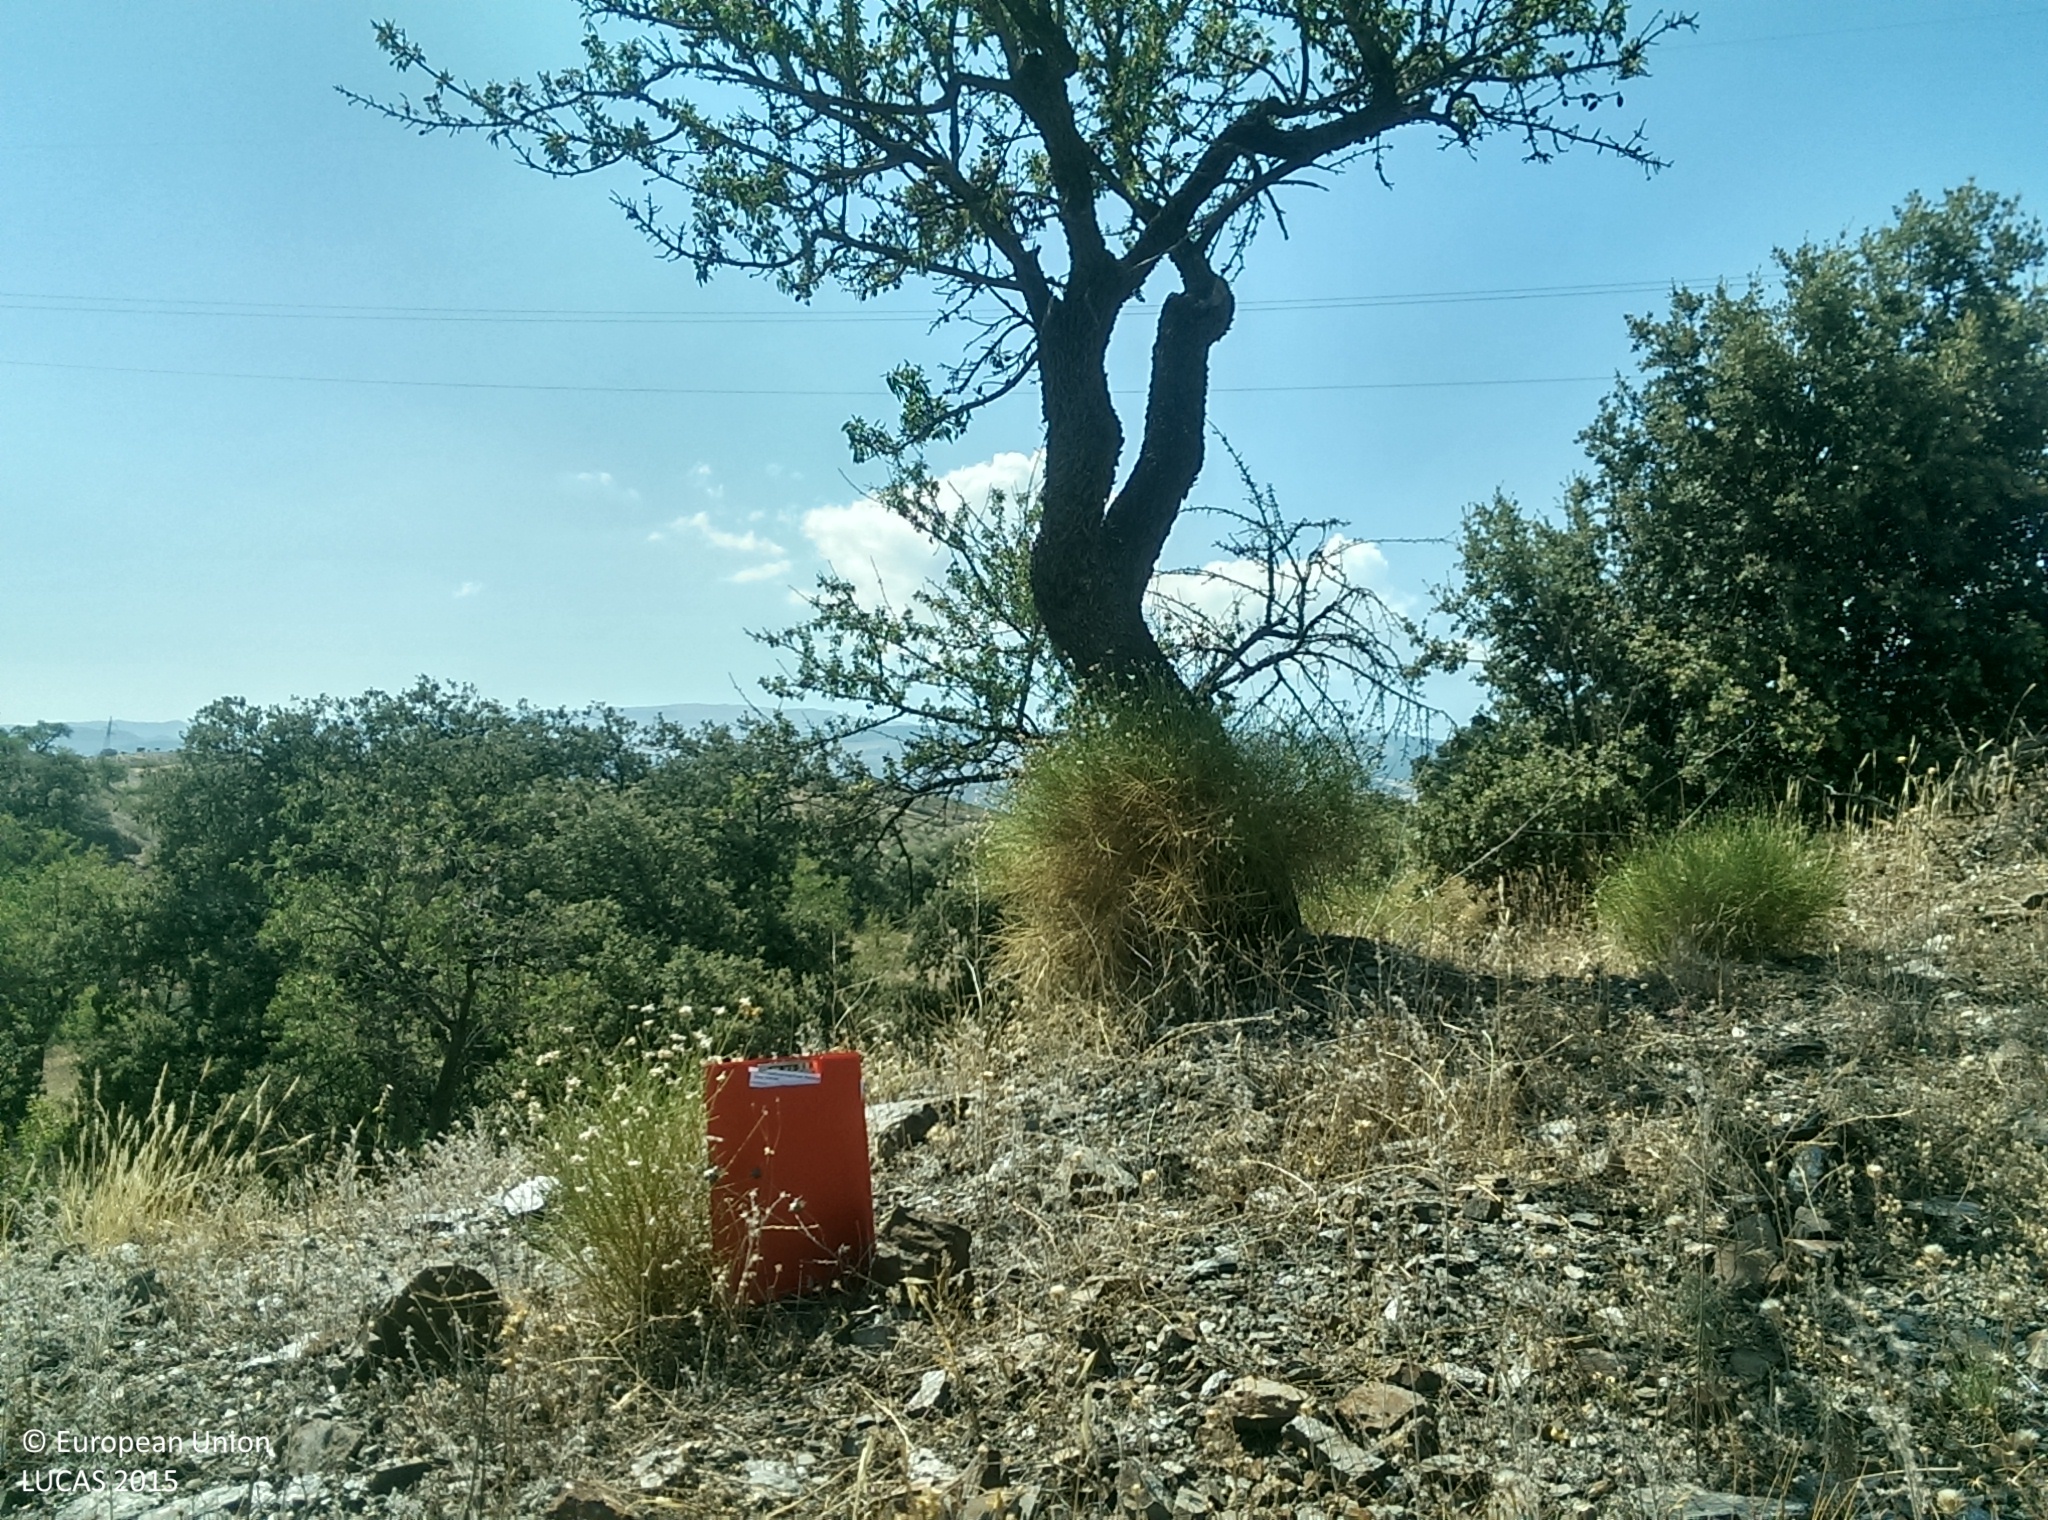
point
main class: Cropland
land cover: Nuts trees
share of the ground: 25 - 50 %
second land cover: Spontaneously vegetated surfaces
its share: 50 - 75 %
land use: Agriculture (excluding fallow land and kitchen gardens)
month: July
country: ES
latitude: 36.9220
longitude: -3.1488
